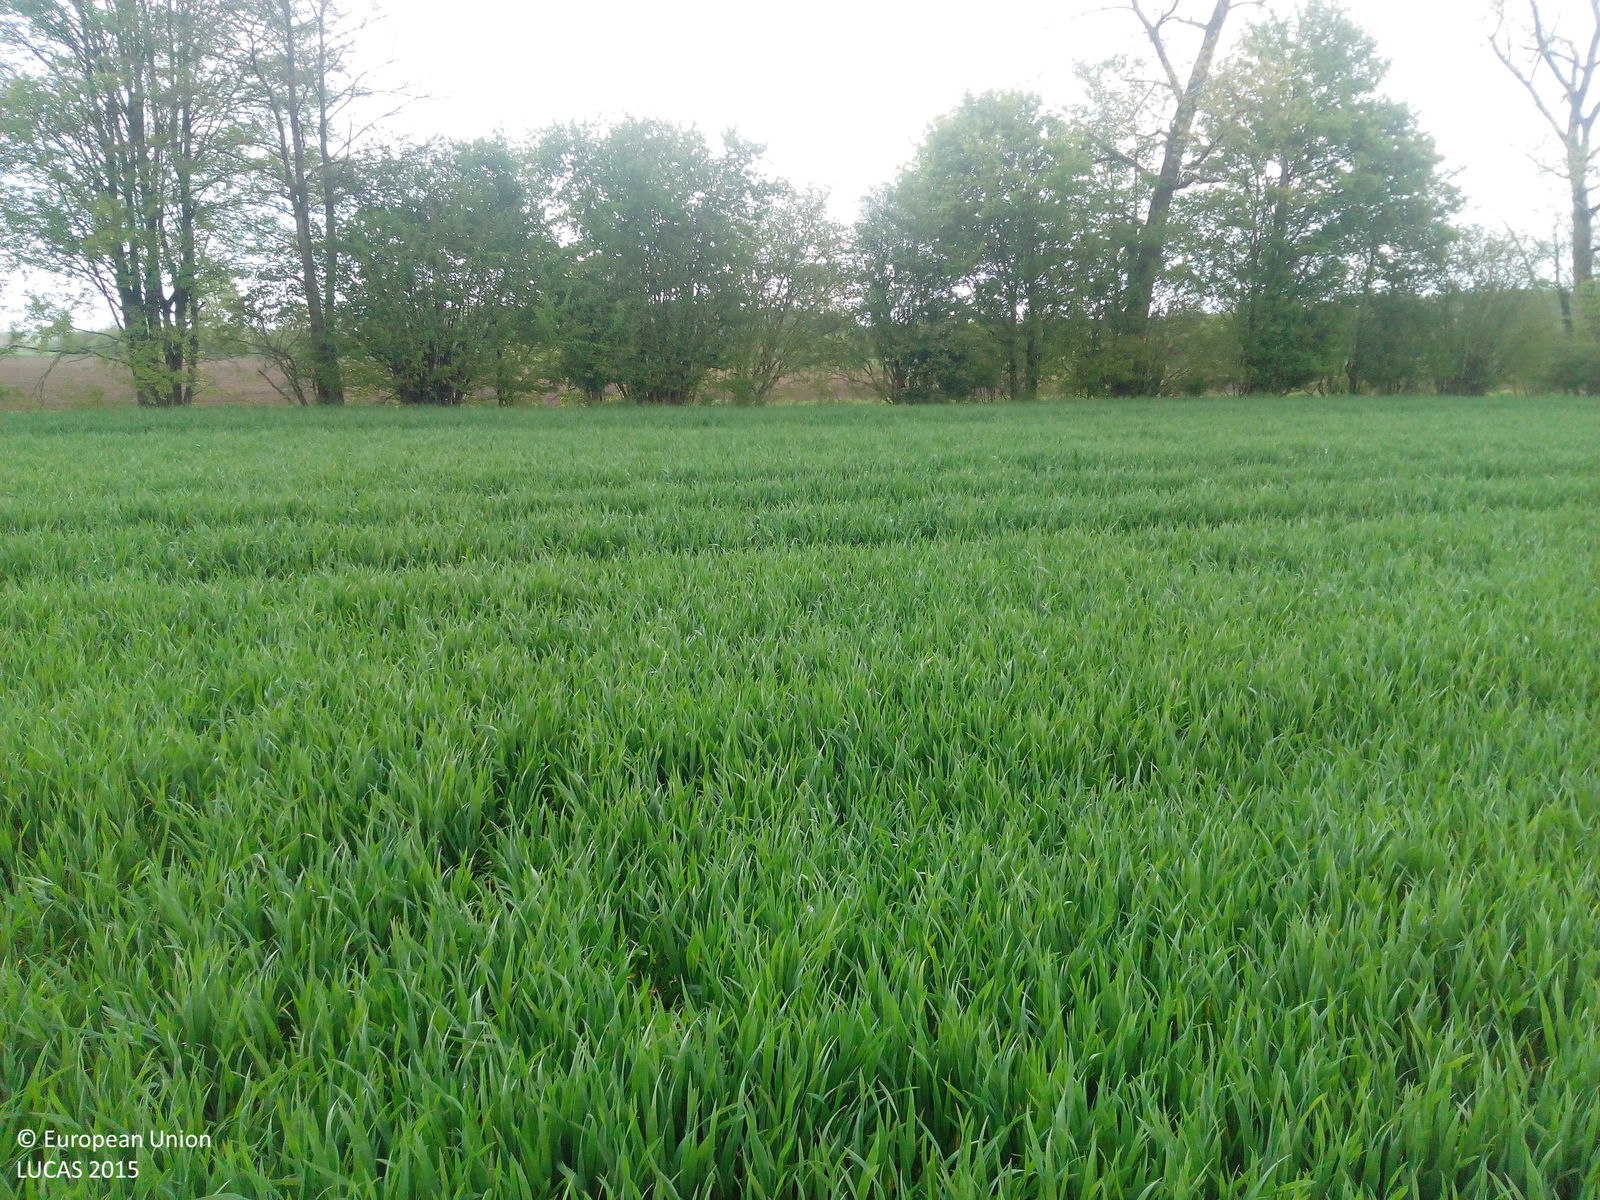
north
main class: Cropland
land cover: Triticale
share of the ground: > 75 %
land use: Agriculture (excluding fallow land and kitchen gardens)
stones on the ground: < 10 %
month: May
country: DE
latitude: 51.8635
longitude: 7.4009
